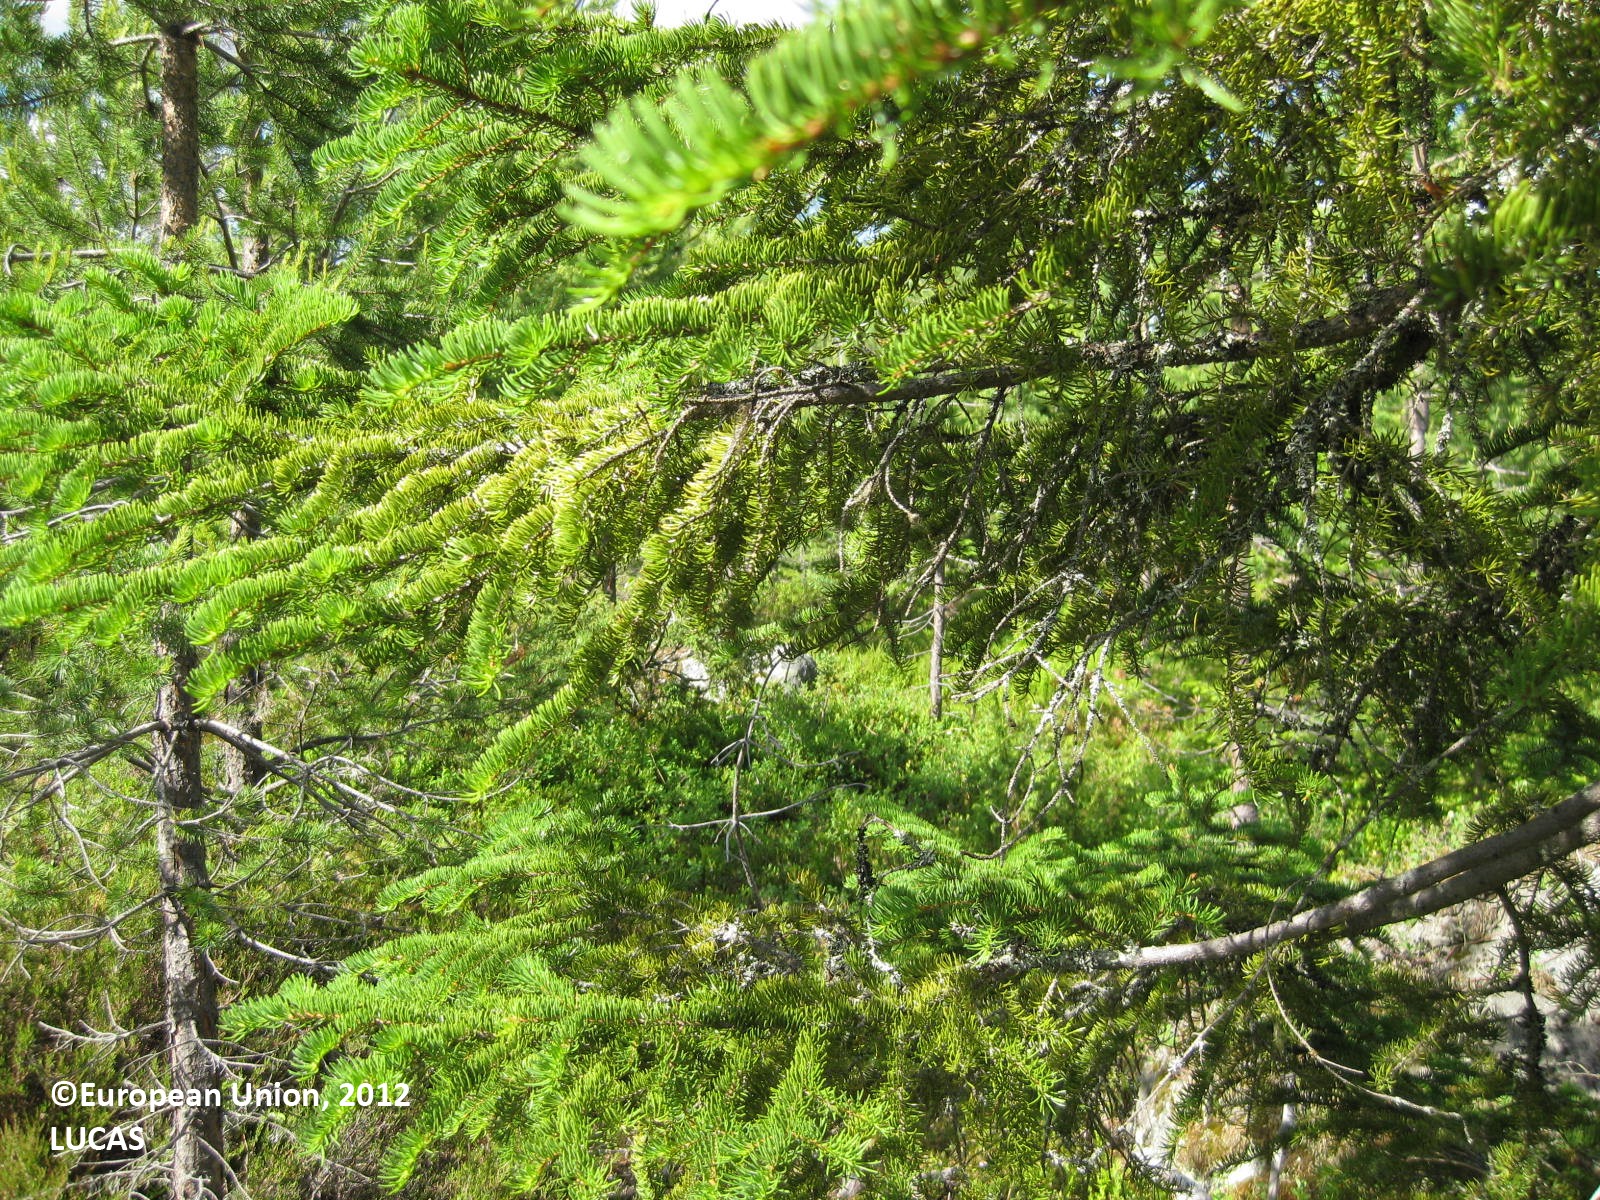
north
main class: Woodland
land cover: Pine dominated coniferous woodland
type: boreal forest
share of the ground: > 75 %
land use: Forestry
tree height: > 5 m
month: July
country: FI
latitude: 65.5962
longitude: 29.4343
